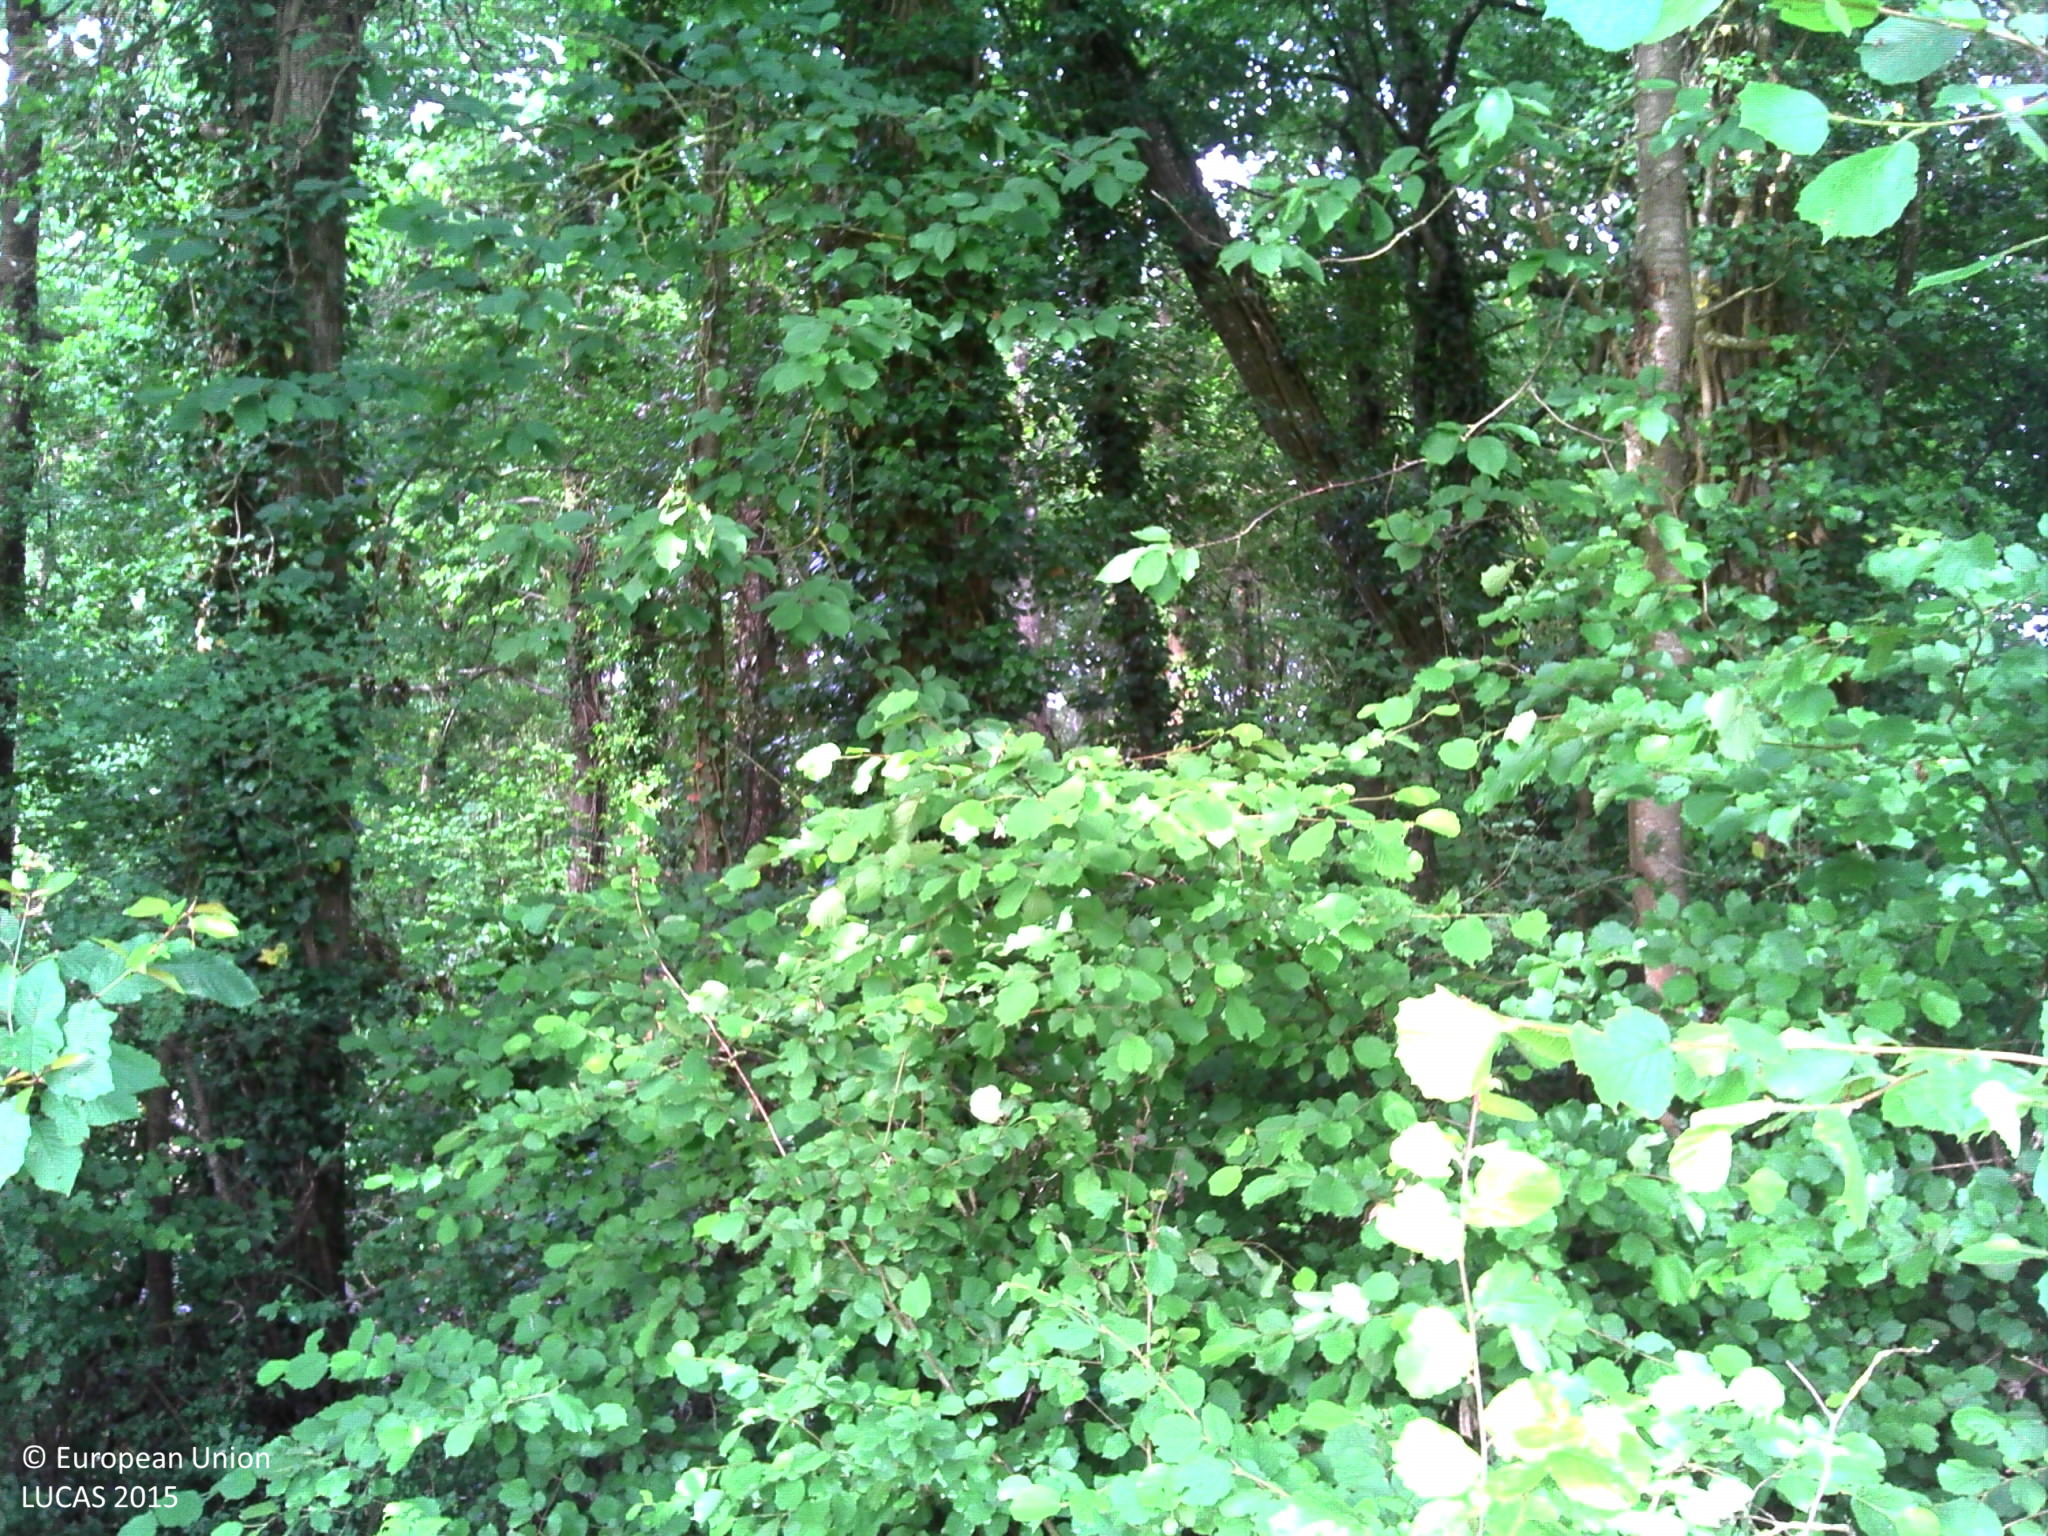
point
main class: Woodland
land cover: Broadleaved woodland
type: acidophilous oak and oak-birch forest
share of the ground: > 75 %
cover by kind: broadleaved forest trees 70 %, shrubs 15 %, herbaceous plants 15 %
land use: Forestry
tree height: > 5 m
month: June
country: FR
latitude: 48.3493
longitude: 0.2170
